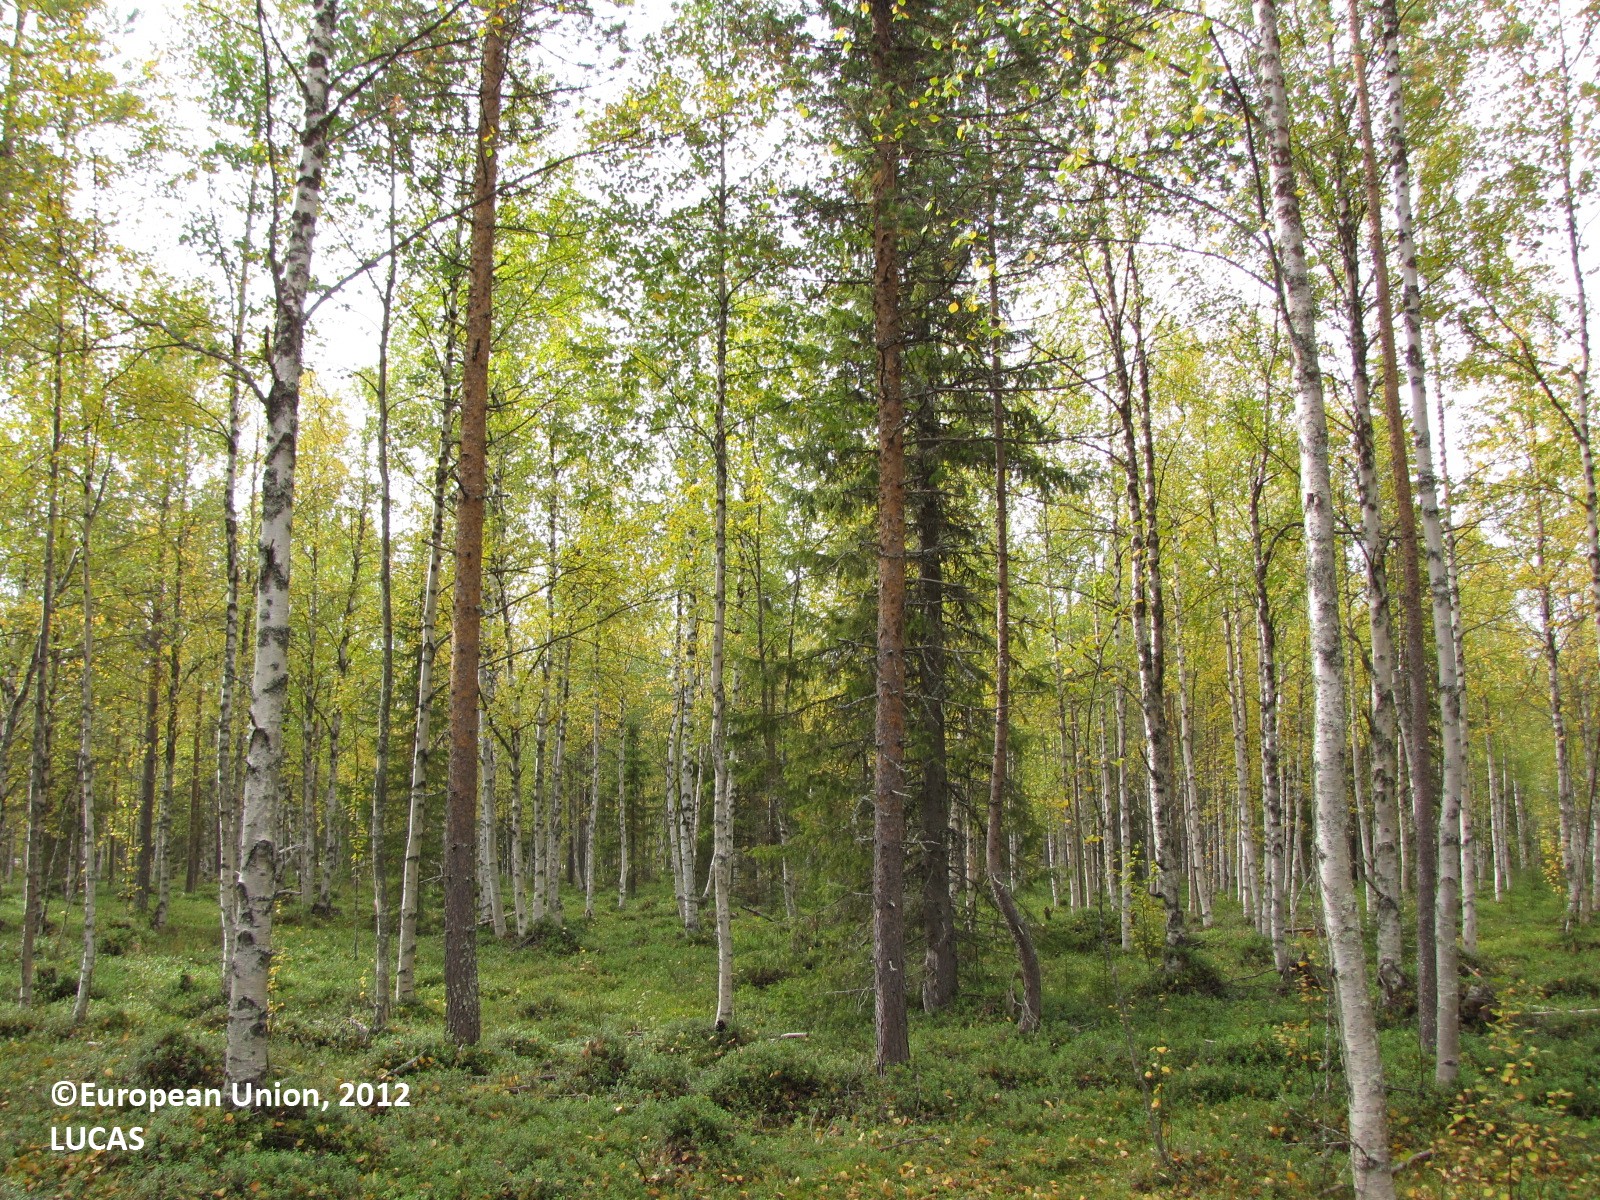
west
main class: Woodland
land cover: Other mixed woodland
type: boreal forest
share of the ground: 50 - 75 %
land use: Forestry
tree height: > 5 m
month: September
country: FI
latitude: 67.2572
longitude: 24.8994
